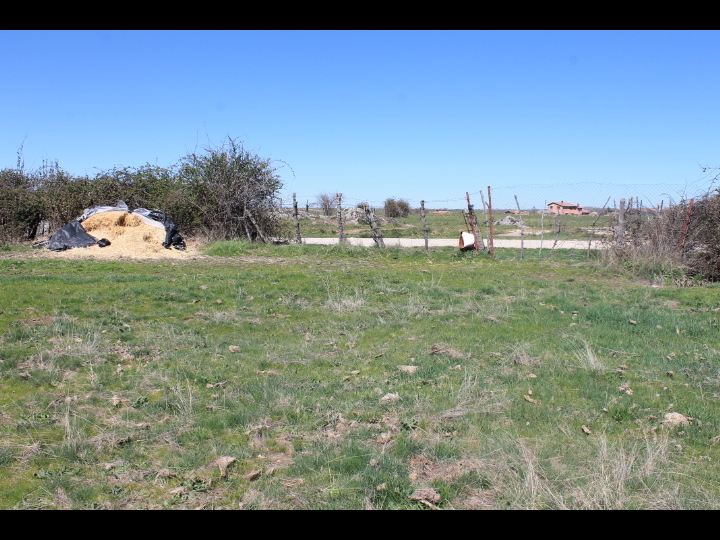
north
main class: Grassland
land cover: Grassland without tree/shrub cover
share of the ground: > 75 %
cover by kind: herbaceous plants 100 %
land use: Agriculture (excluding fallow land and kitchen gardens)
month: April
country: ES
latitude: 40.9364
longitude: -4.0522
